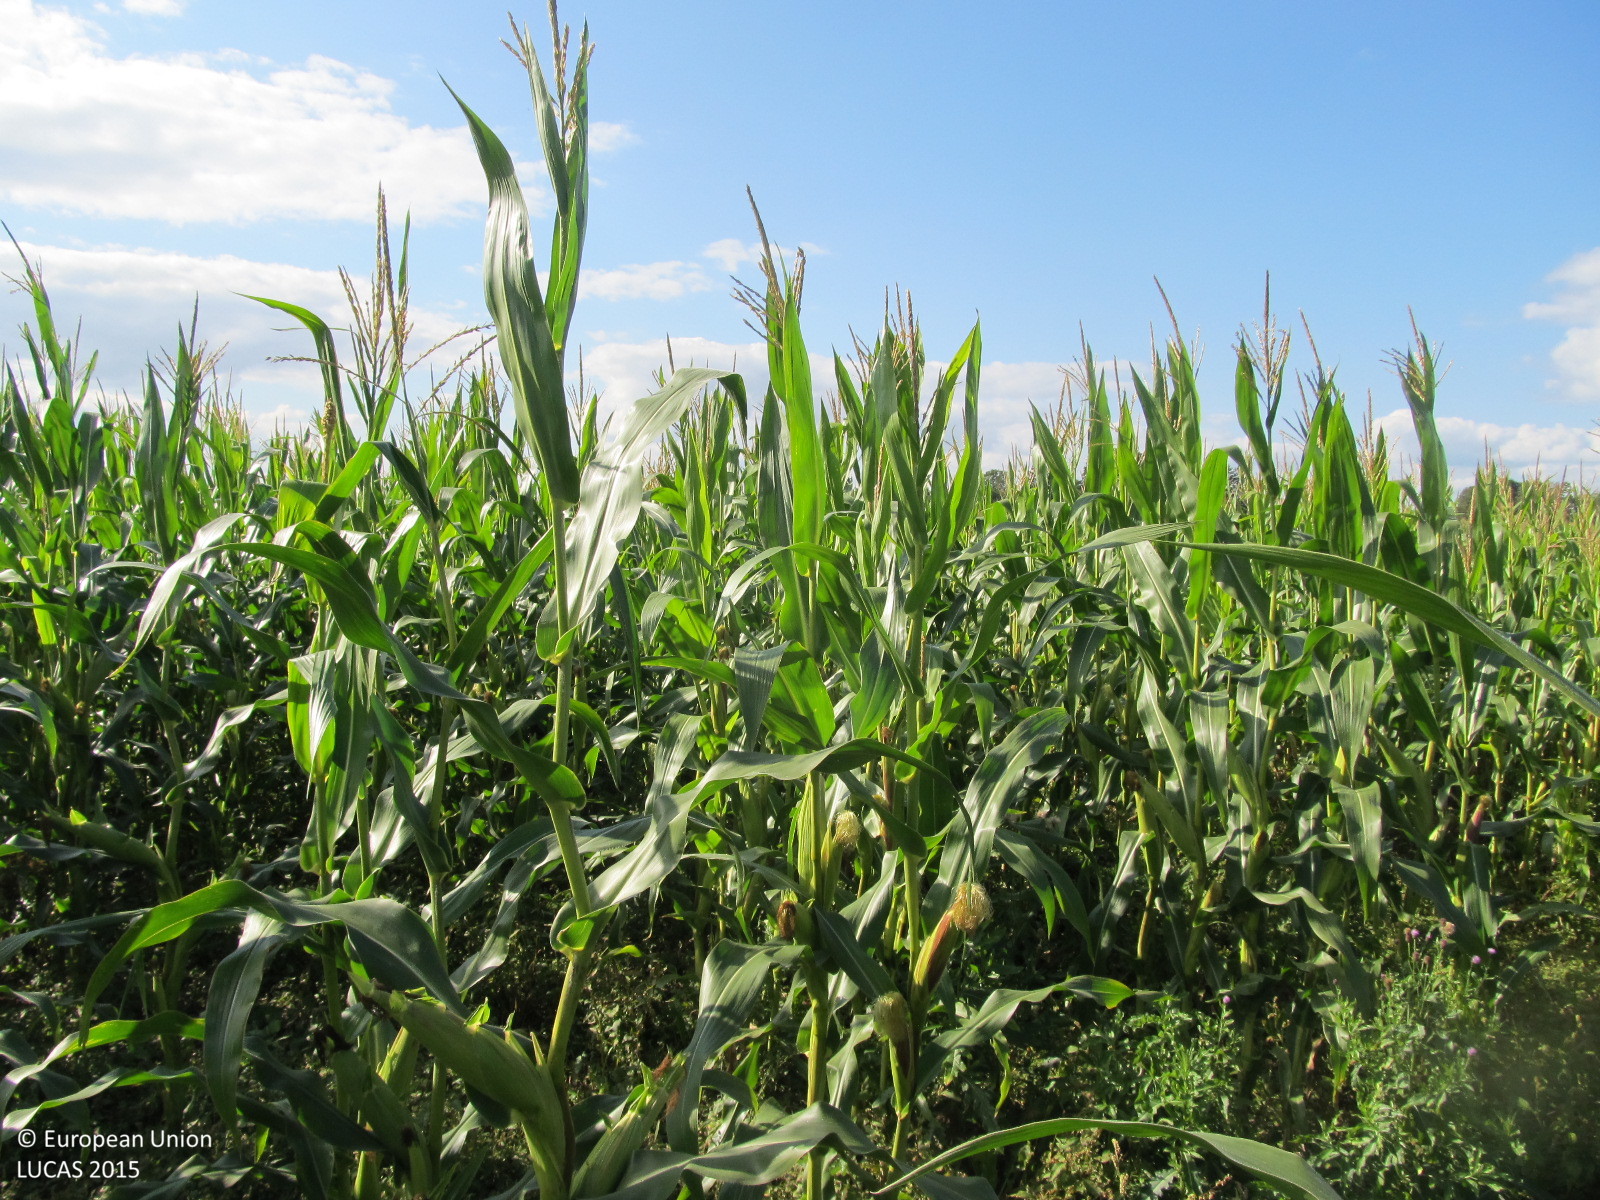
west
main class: Cropland
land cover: Maize
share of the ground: > 75 %
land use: Agriculture (excluding fallow land and kitchen gardens)
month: September
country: LT
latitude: 56.2898
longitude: 22.8104
